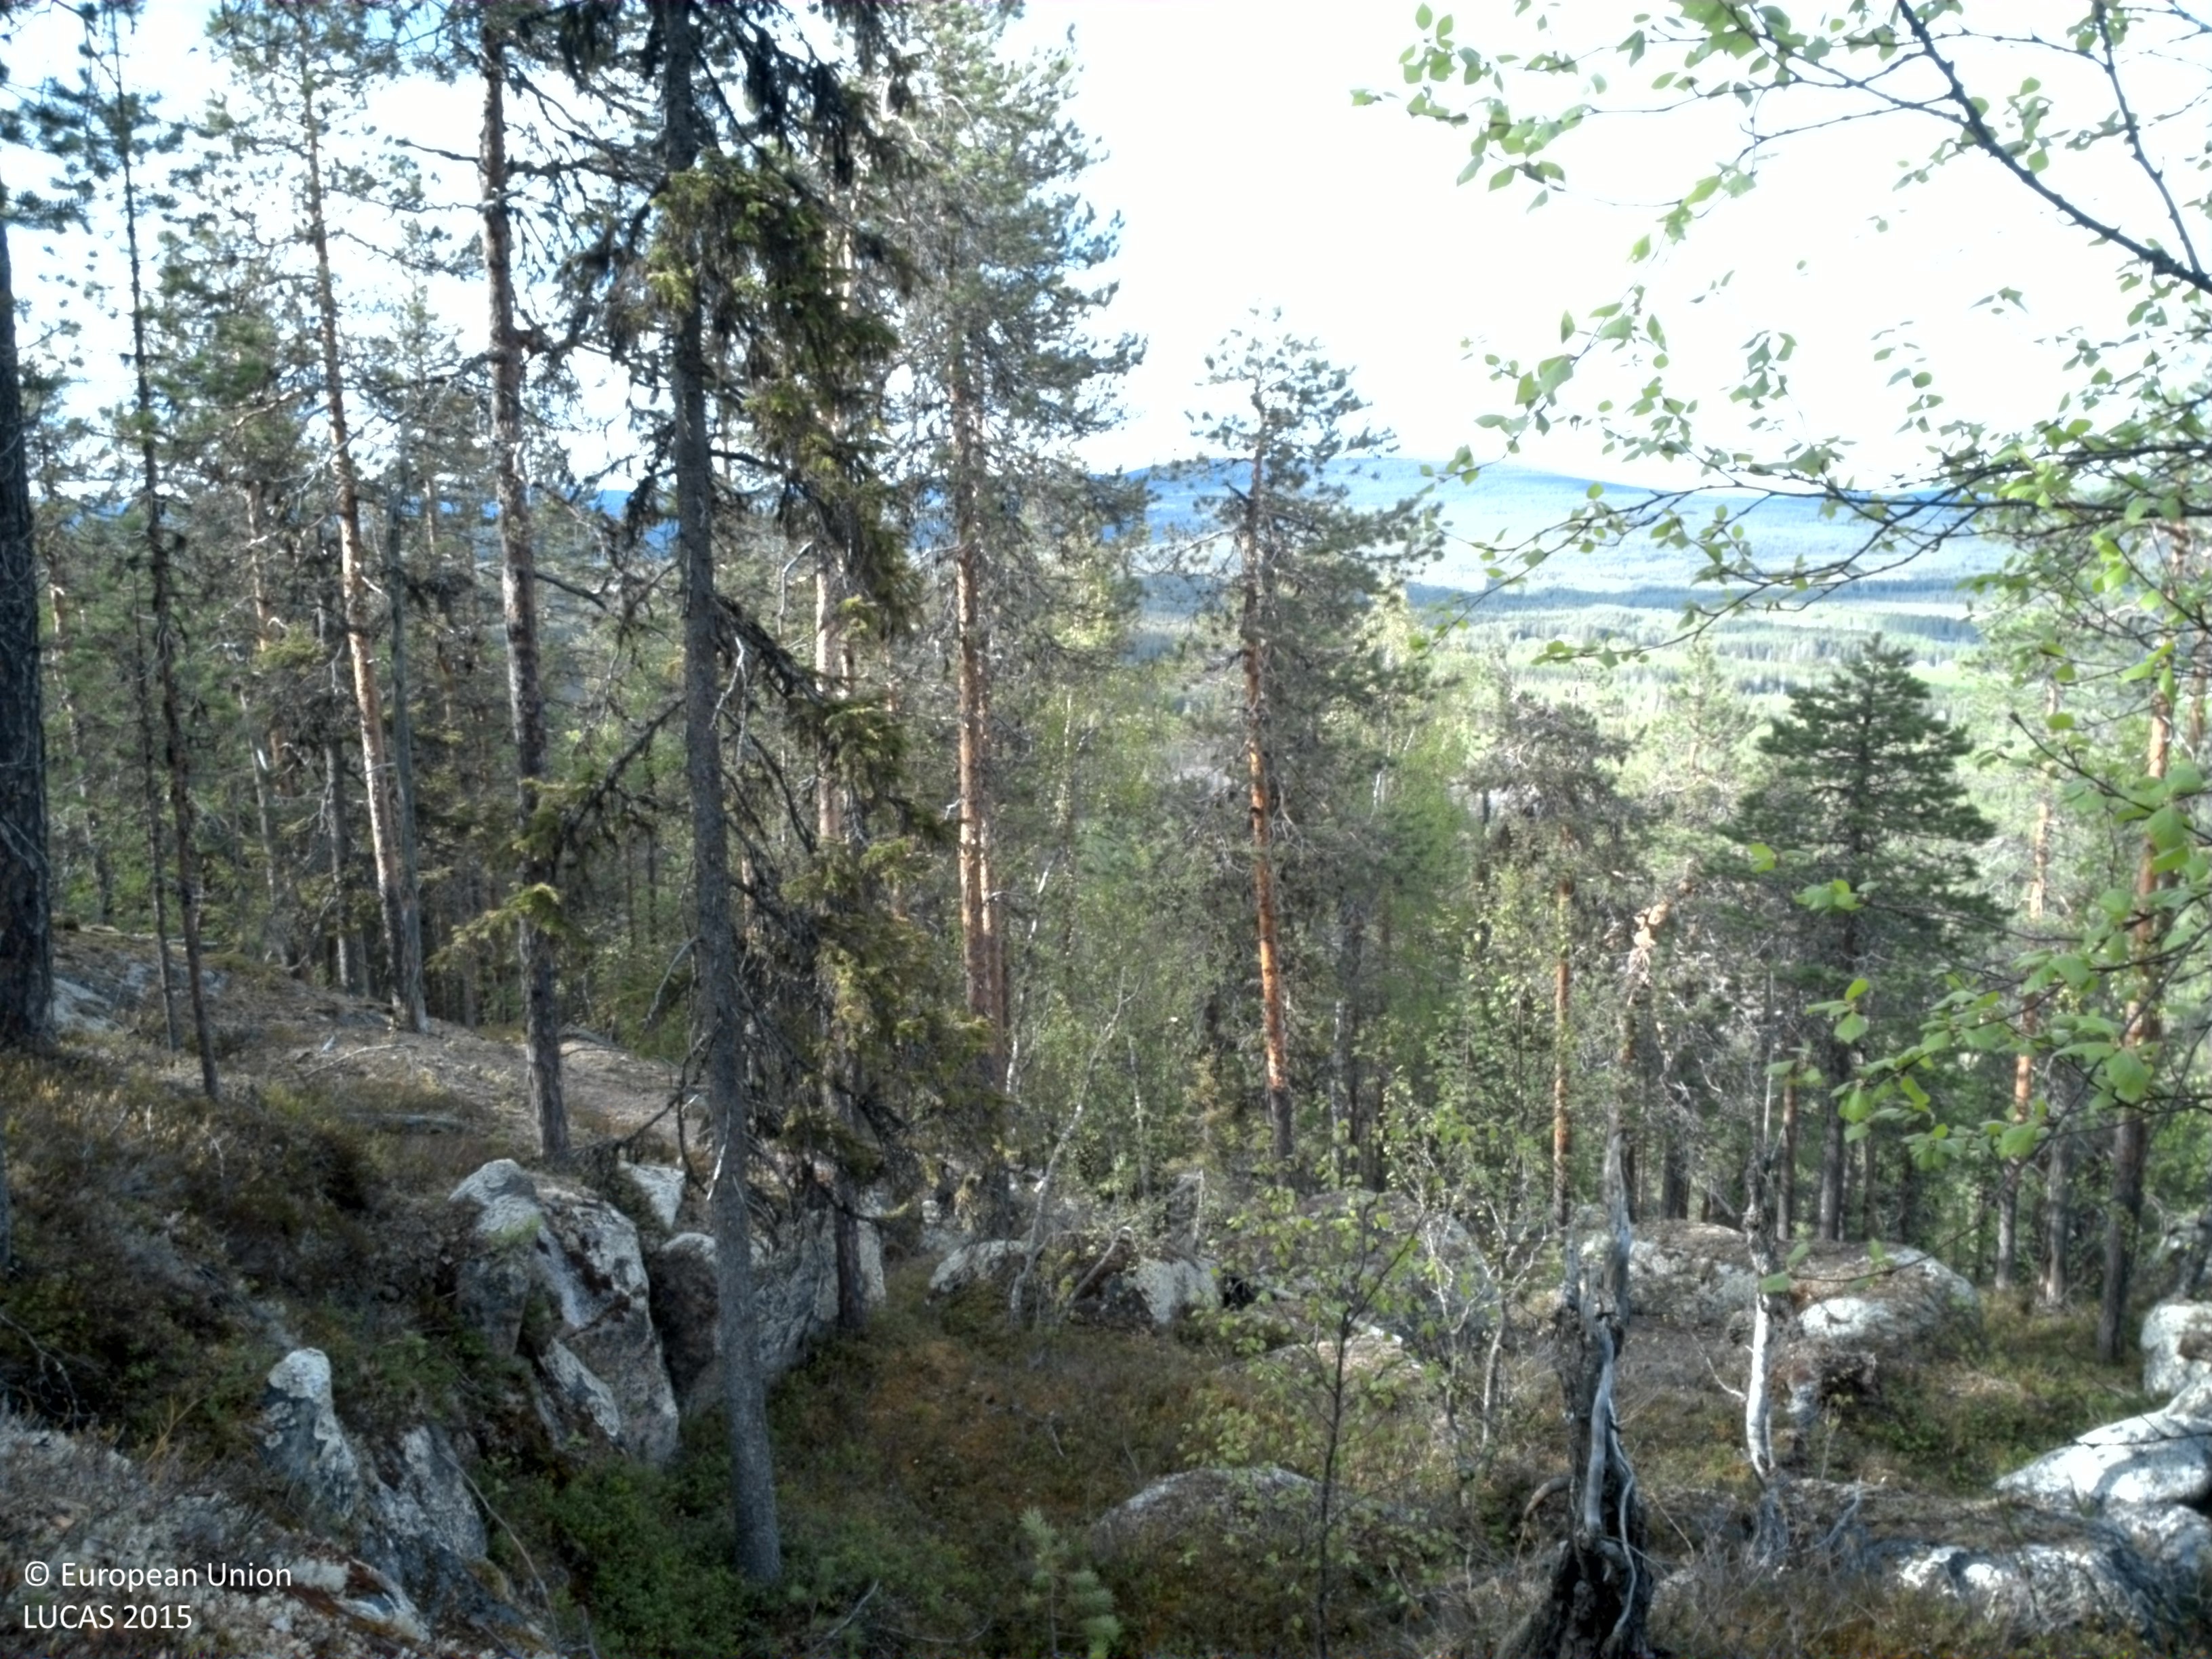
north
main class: Woodland
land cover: Pine dominated coniferous woodland
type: boreal forest
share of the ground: 50 - 75 %
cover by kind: coniferous forest trees 50 %, shrubs 40 %, broadleaved forest trees 5 %, consolidated bare surface 5 %
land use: Semi-natural and natural areas not in use
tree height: > 5 m
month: June
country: SE
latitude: 66.4634
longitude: 22.6077
